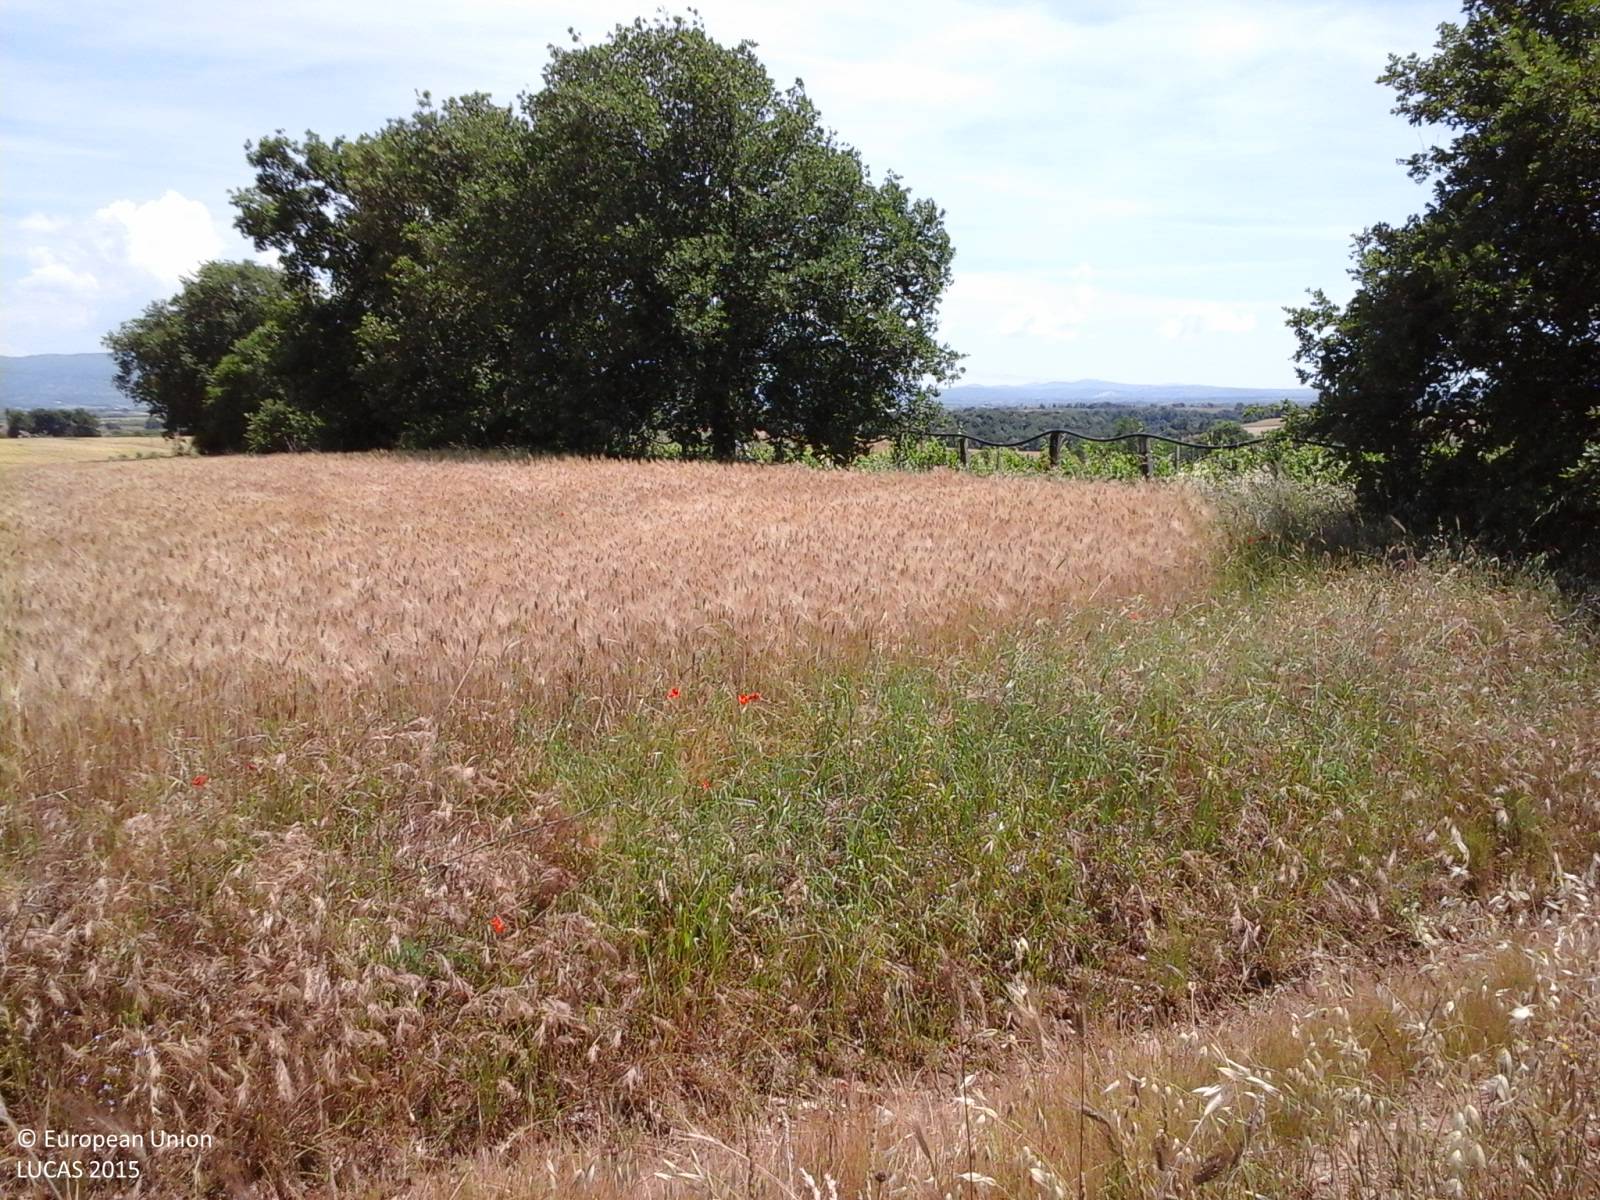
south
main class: Cropland
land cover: Durum wheat
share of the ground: > 75 %
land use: Agriculture (excluding fallow land and kitchen gardens)
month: June
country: IT
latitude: 42.4360
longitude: 11.9747
